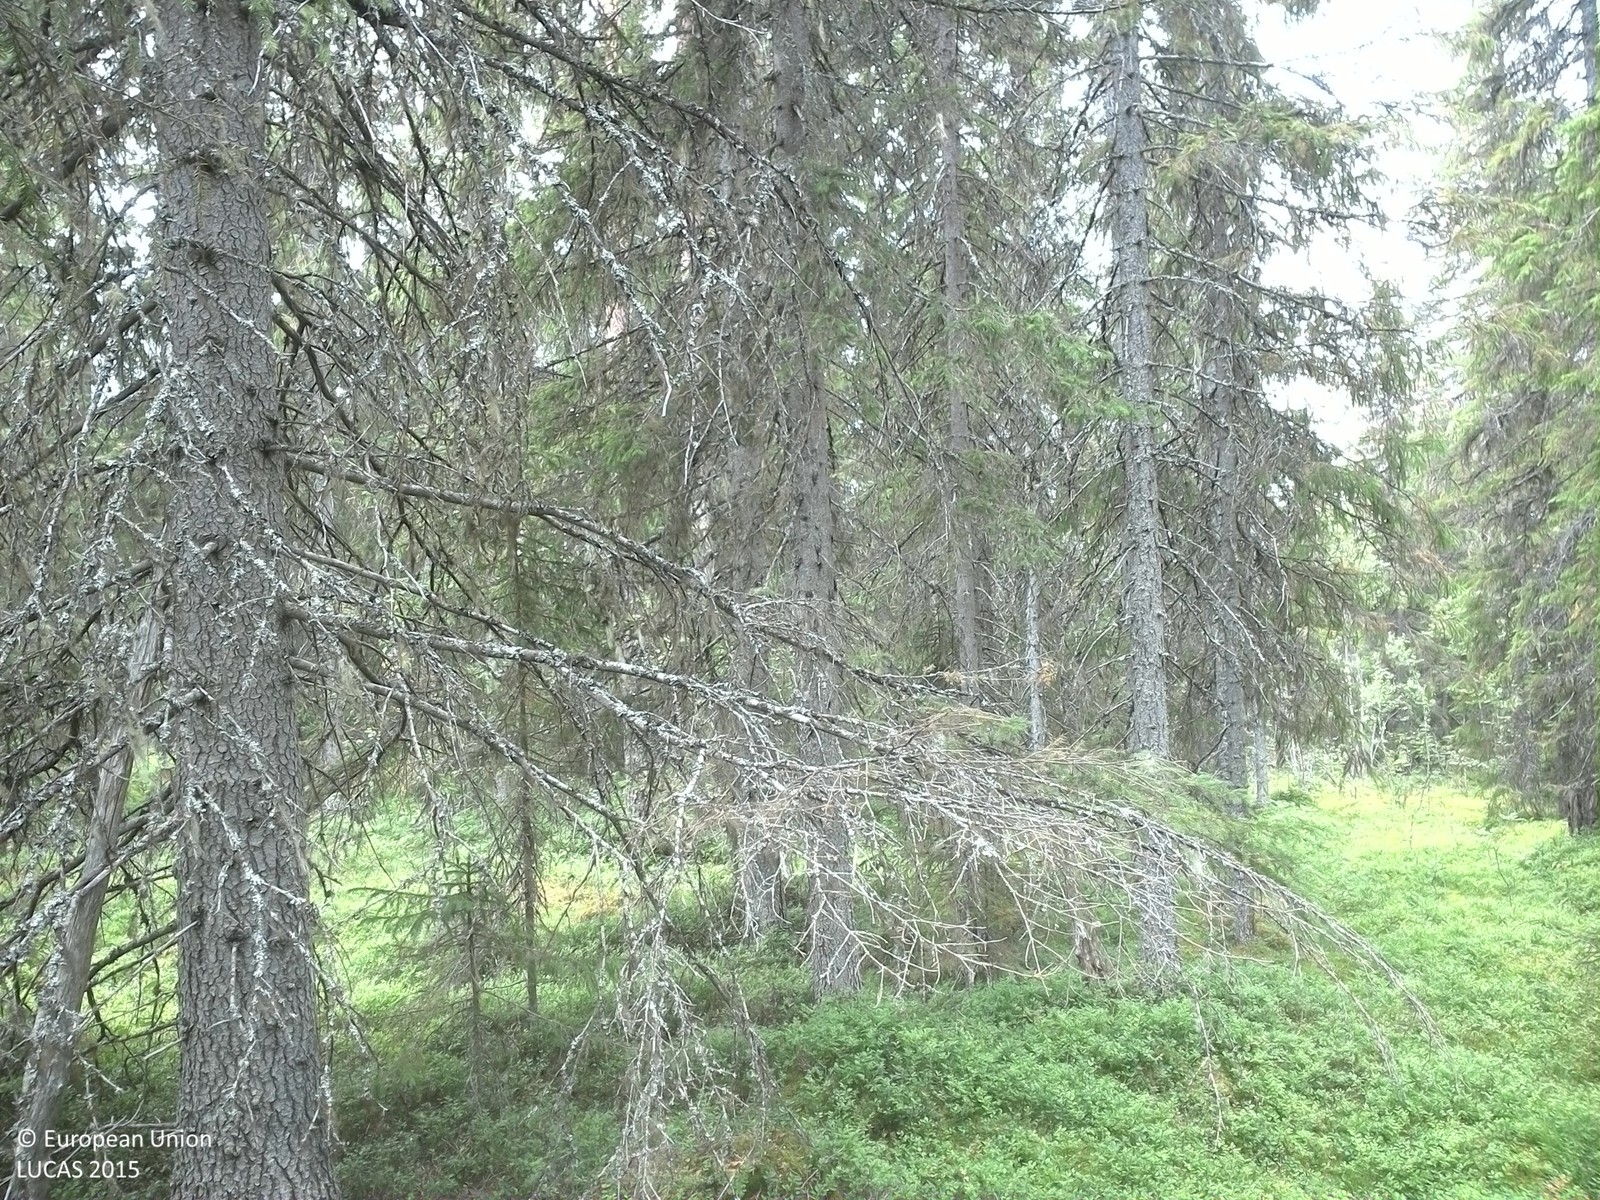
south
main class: Woodland
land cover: Spruce dominated coniferous woodland
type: boreal forest
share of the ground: > 75 %
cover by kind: coniferous forest trees 75 %, shrubs 20 %, lichens and mosses 5 %
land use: Forestry
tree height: > 5 m
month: August
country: SE
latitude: 63.7929
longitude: 17.3393
